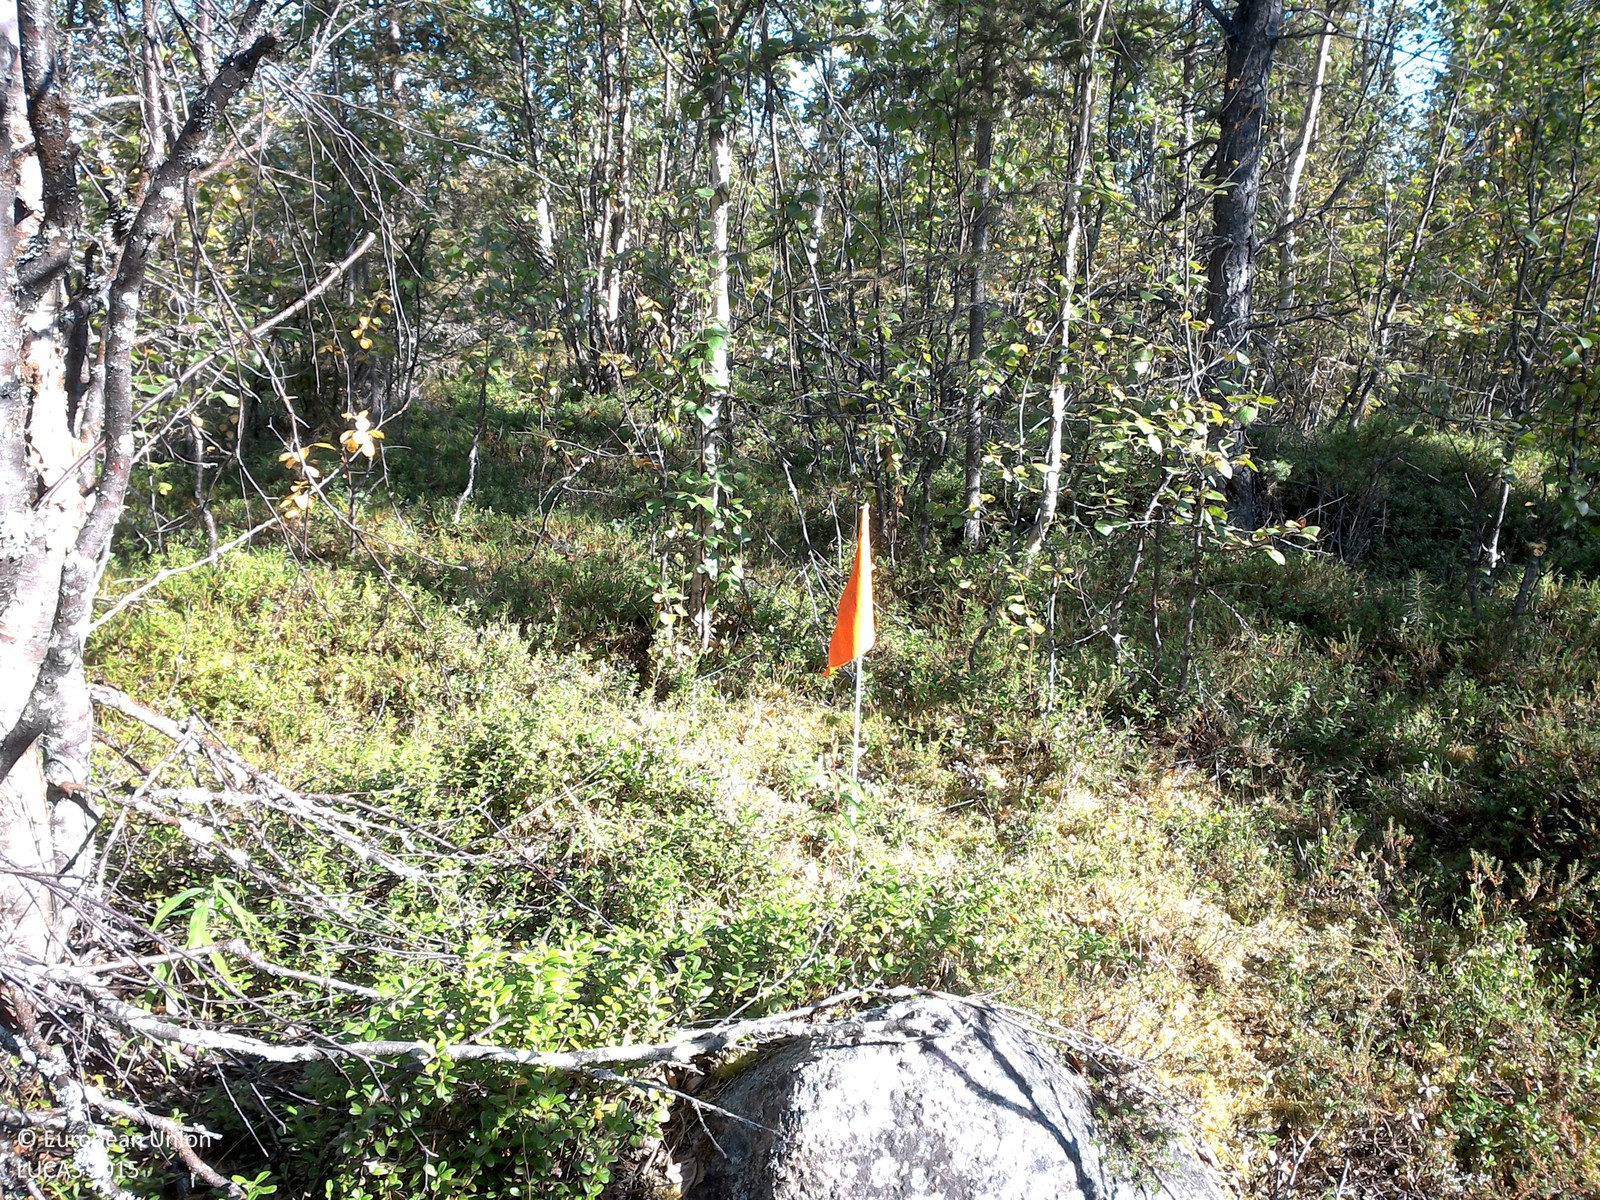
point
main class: Woodland
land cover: Other mixed woodland
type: boreal forest
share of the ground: 25 - 50 %
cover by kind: shrubs 60 %, broadleaved forest trees 25 %, coniferous forest trees 10 %, lichens and mosses 5 %
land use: Forestry
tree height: > 5 m
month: August
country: SE
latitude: 67.3828
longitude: 22.0959
